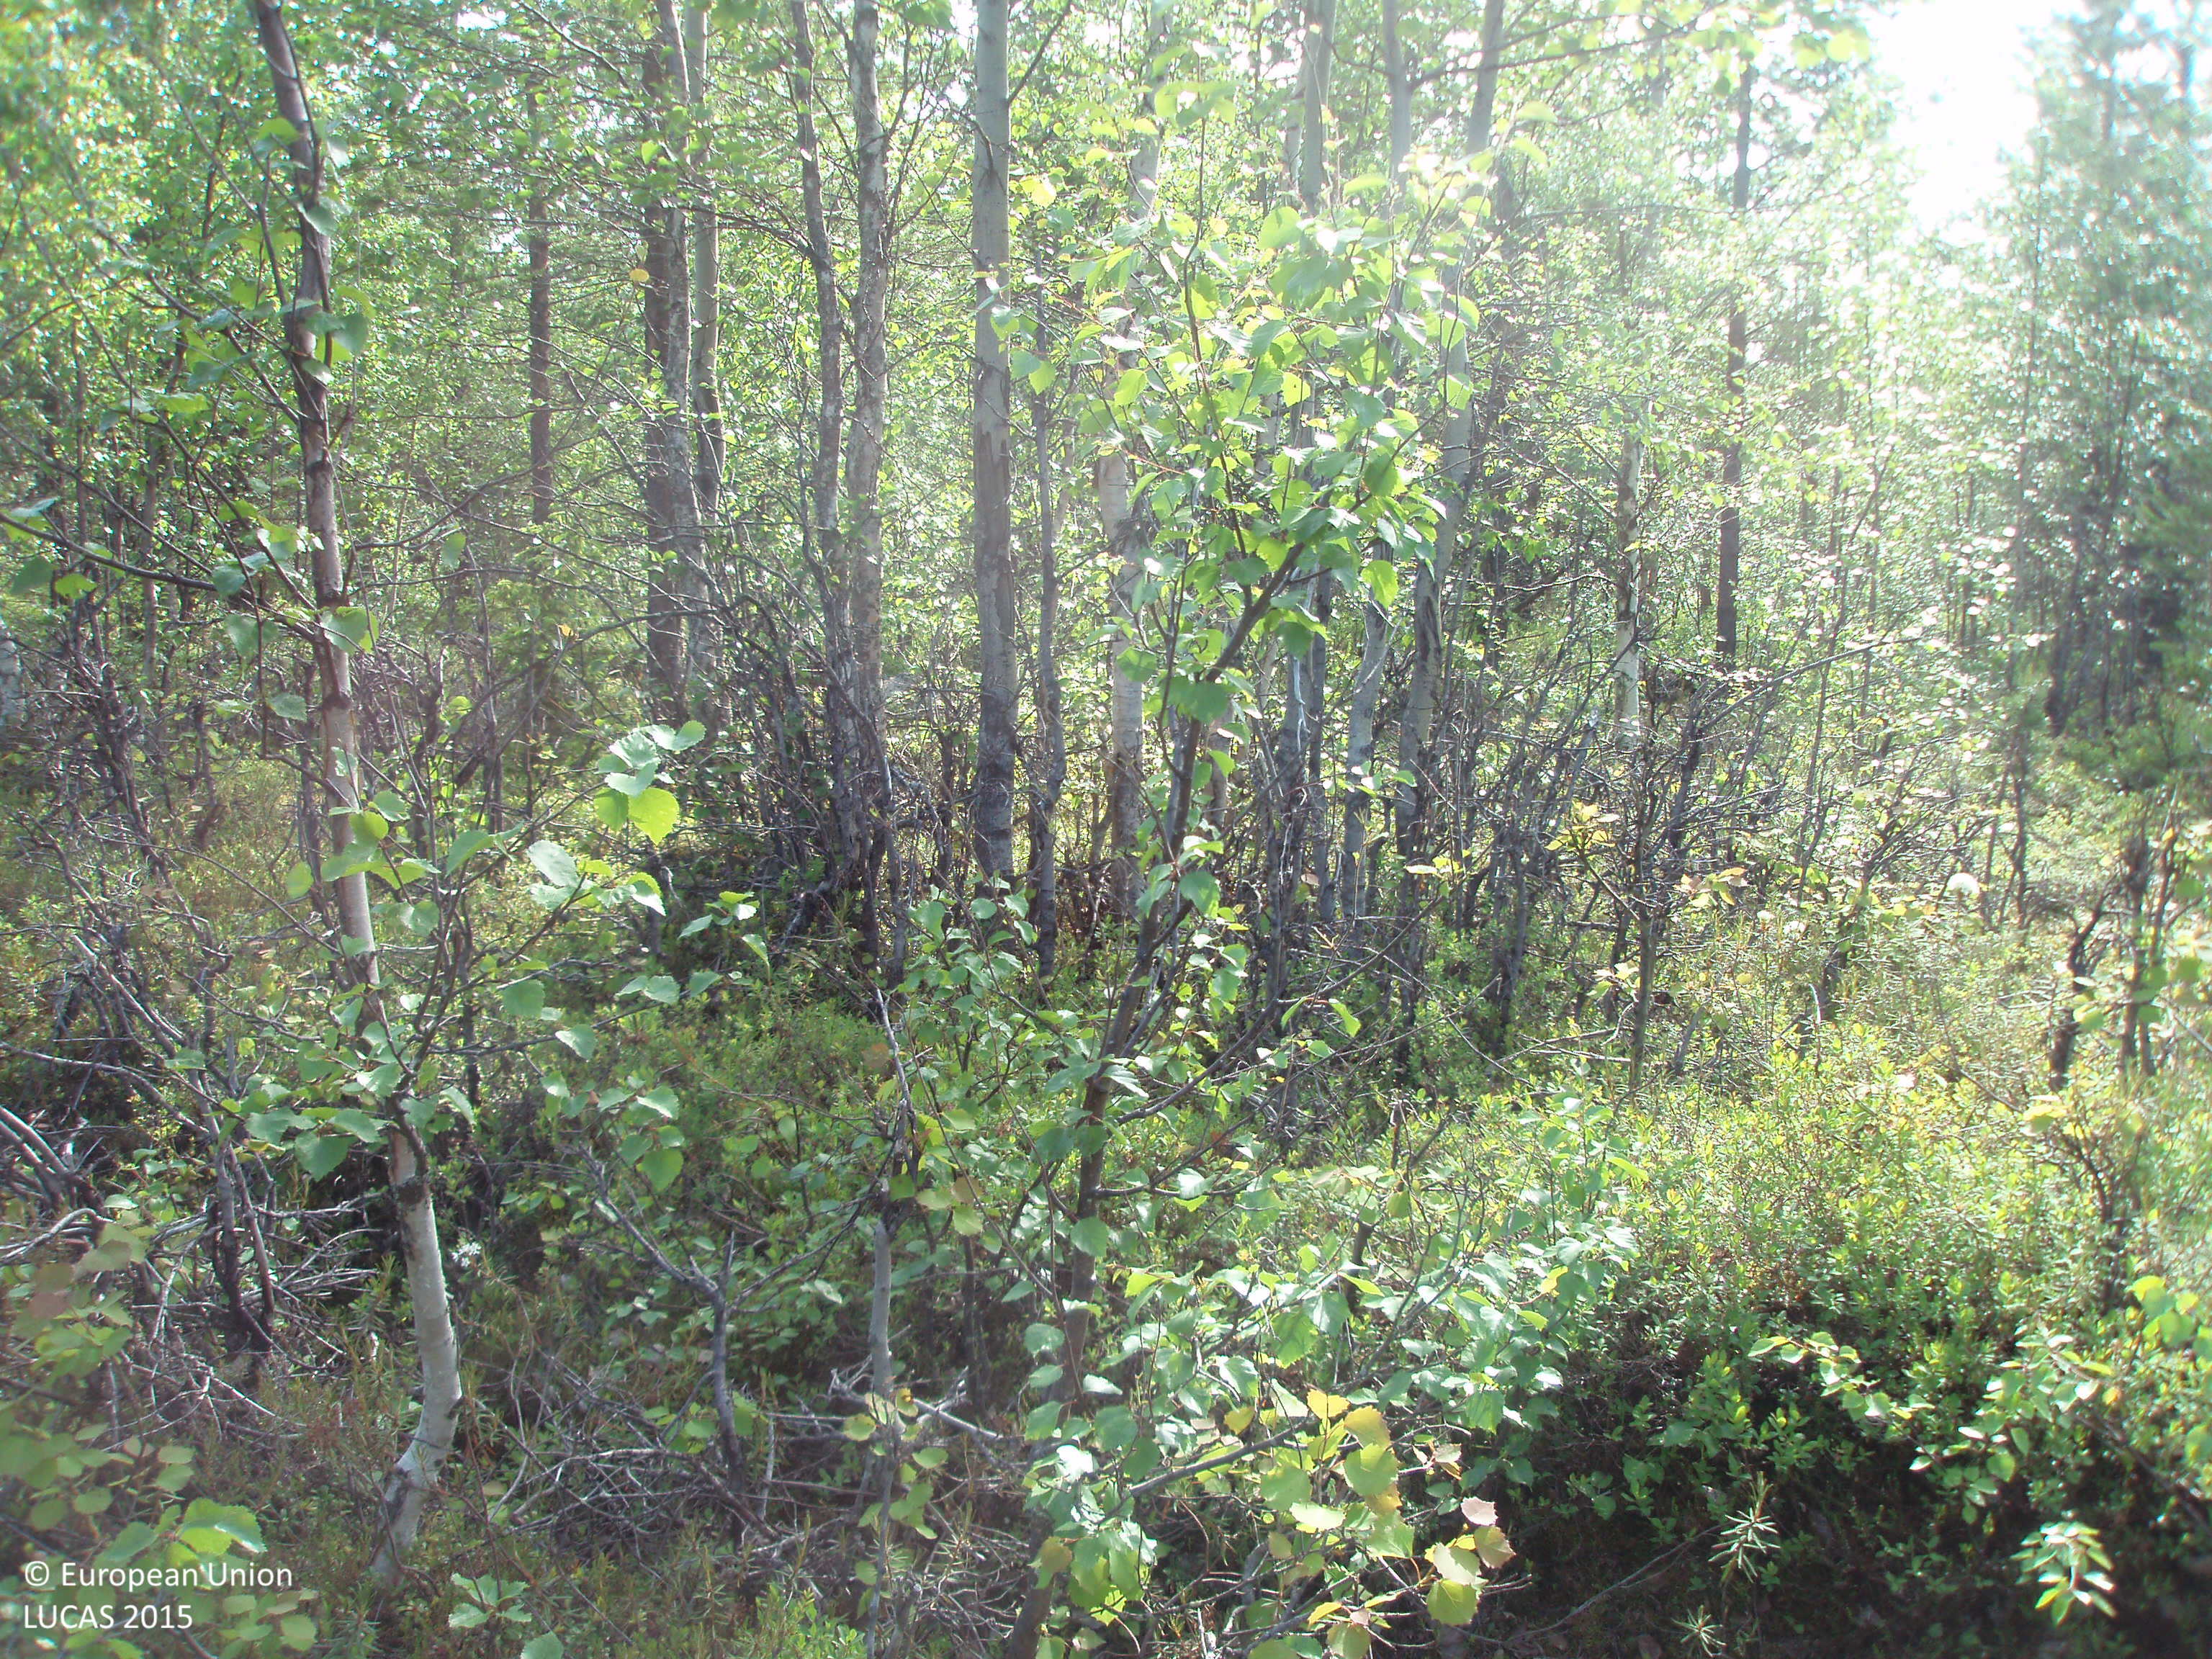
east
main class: Woodland
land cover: Pine dominated mixed woodland
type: boreal forest
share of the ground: > 75 %
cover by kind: coniferous forest trees 40 %, broadleaved forest trees 35 %, shrubs 25 %
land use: Forestry
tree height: > 5 m
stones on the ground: 10 - 25 %
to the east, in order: Pine dominated mixed woodland; Ditches and canals; Pine dominated mixed woodland; Ditches and canals; Pine dominated mixed woodland; Ditches and canals; Pine dominated mixed woodland; Ditches and canals; Pine dominated mixed woodland; Ditches and canals; Pine dominated mixed woodland; Ditches and canals; Pine dominated mixed woodland; Ditches and canals; Pine dominated mixed woodland; Ditches and canals; Pine dominated mixed woodland; Ditches and canals; Pine dominated mixed woodland; Ditches and canals; Pine dominated mixed woodland; Ditches and canals; Pine dominated mixed woodland; Ditches and canals; Pine dominated mixed woodland; Ditches and canals; Pine dominated mixed woodland; Ditches and canals; Pine dominated mixed woodland; Ditches and canals; Pine dominated coniferous woodland; Electric lines; Pine dominated mixed woodland; Shruby margins; Paved roads, cycling and walking lanes; Shrubland with sparse tree cover; Pine dominated mixed woodland
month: July
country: FI
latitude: 67.7375
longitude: 27.7215
